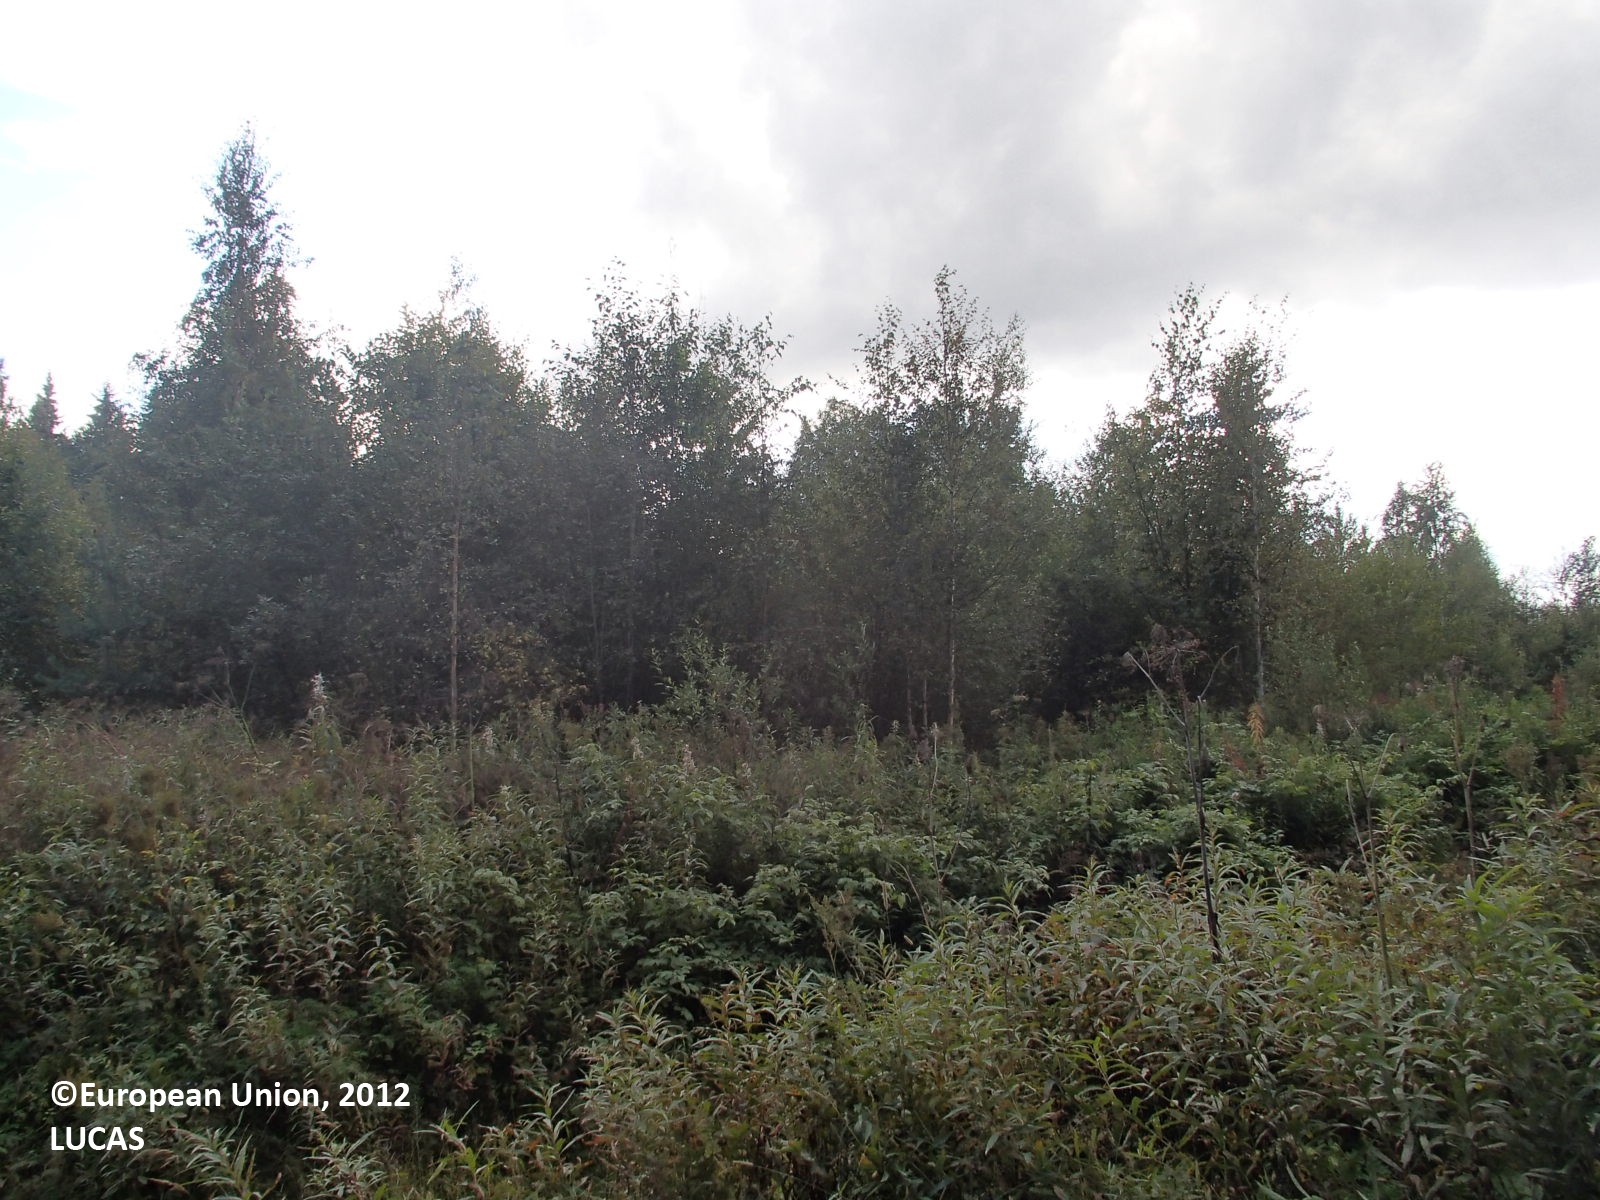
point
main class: Woodland
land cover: Broadleaved woodland
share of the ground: > 75 %
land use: Forestry
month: August
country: FI
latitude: 63.5291
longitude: 26.9701
